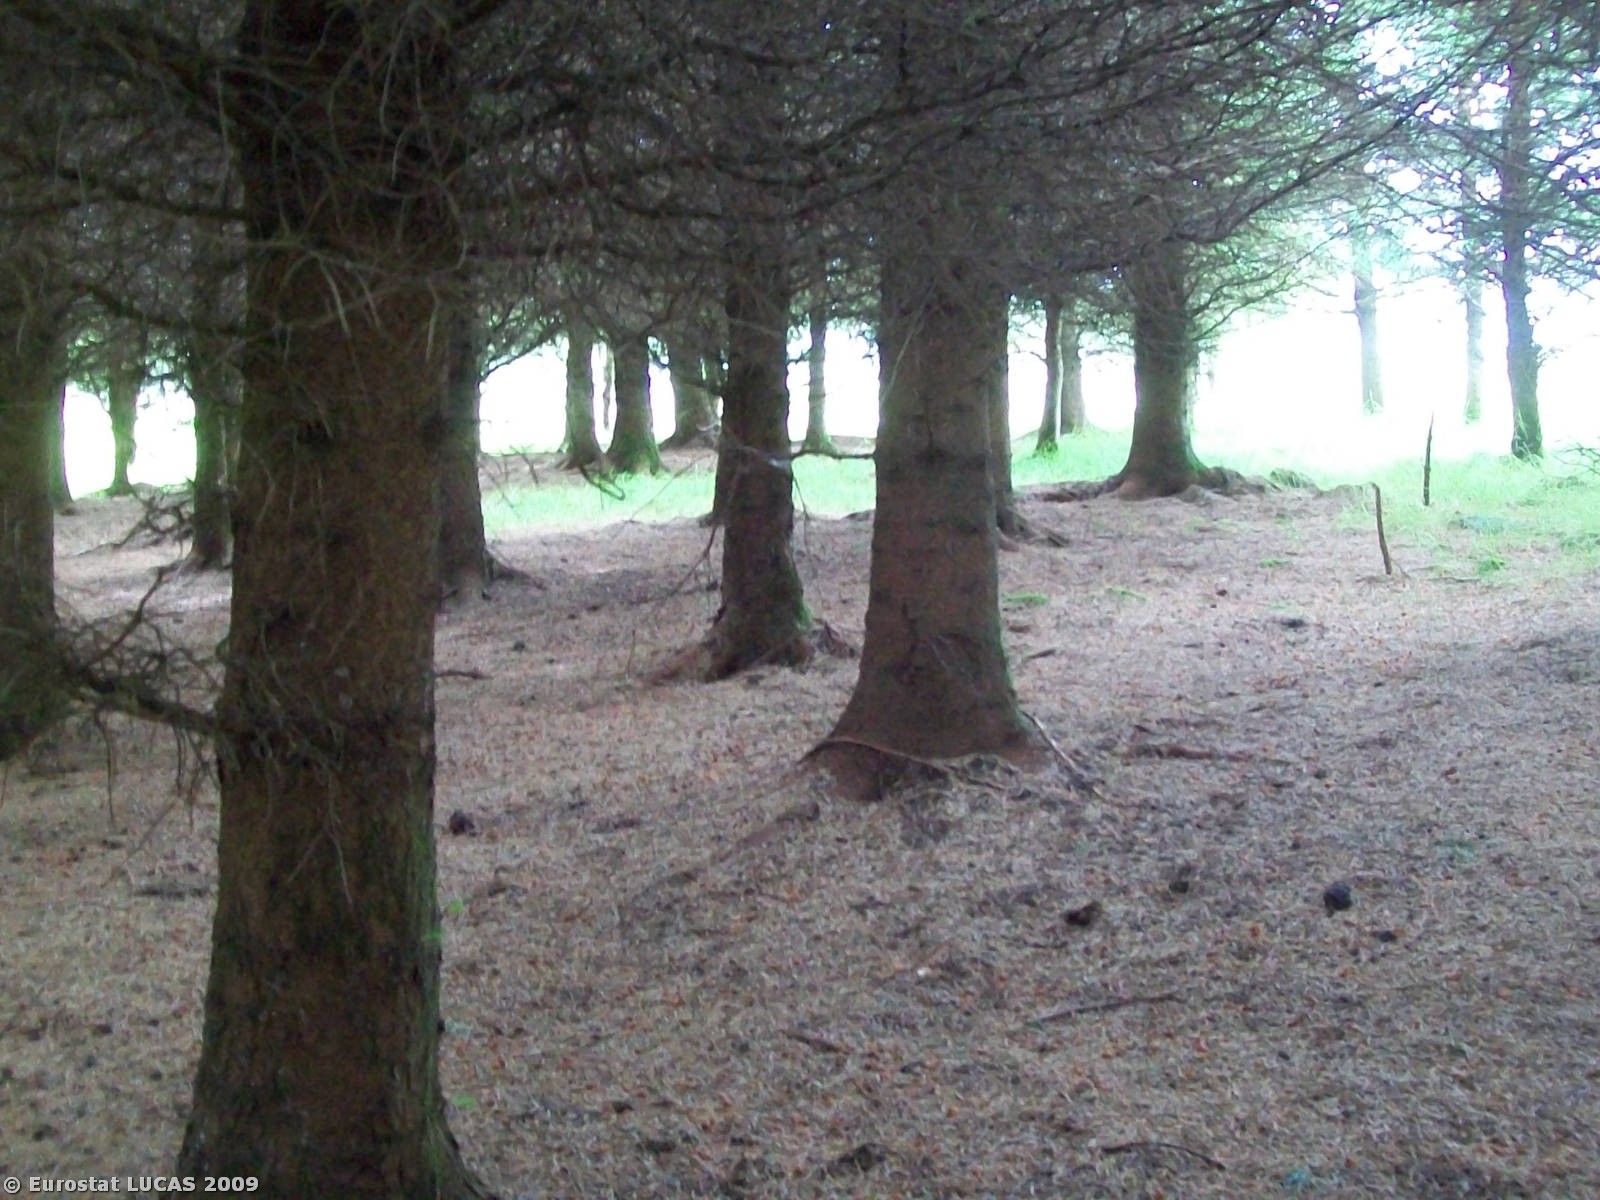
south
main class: Woodland
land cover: Coniferous woodland
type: plantations and self-sown exotic forest
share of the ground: > 75 %
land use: Forestry
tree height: > 5 m
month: July
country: GB
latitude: 54.8975
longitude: -6.8334
